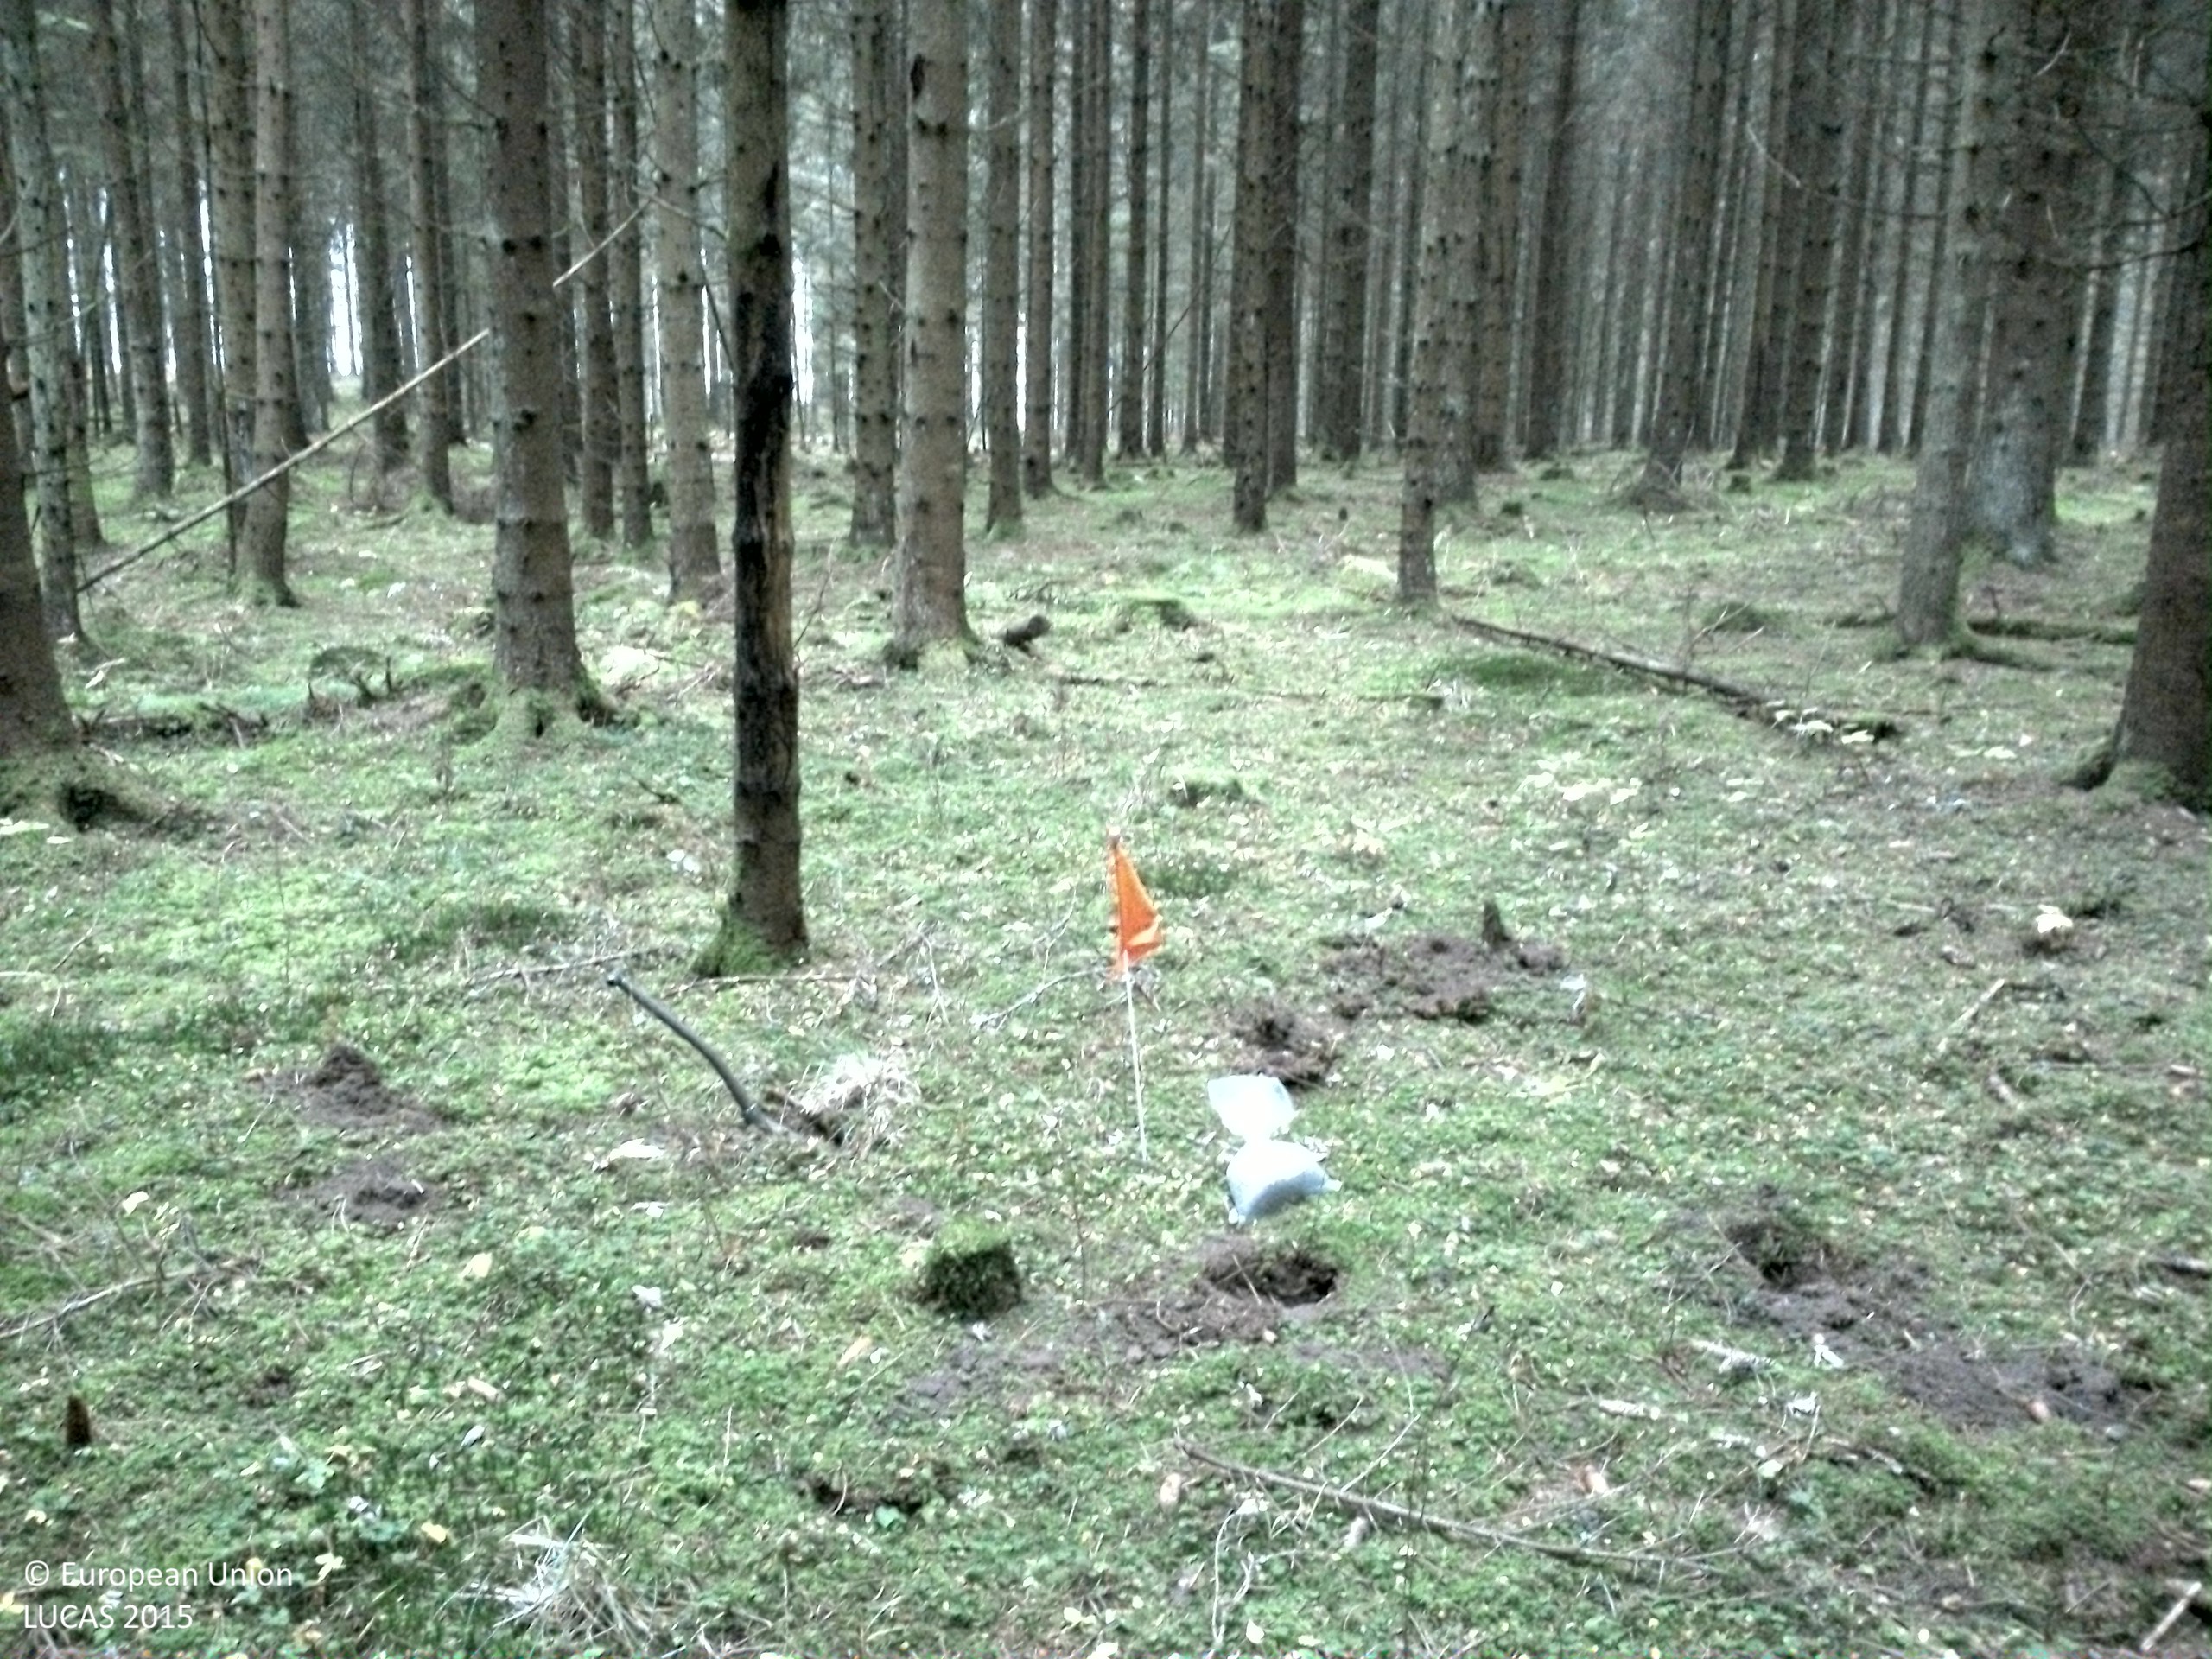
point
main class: Woodland
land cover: Spruce dominated coniferous woodland
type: boreal forest
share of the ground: > 75 %
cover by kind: coniferous forest trees 75 %, lichens and mosses 20 %, shrubs 5 %
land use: Forestry
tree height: > 5 m
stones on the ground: < 10 %
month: November
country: SE
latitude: 57.8394
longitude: 14.4586
